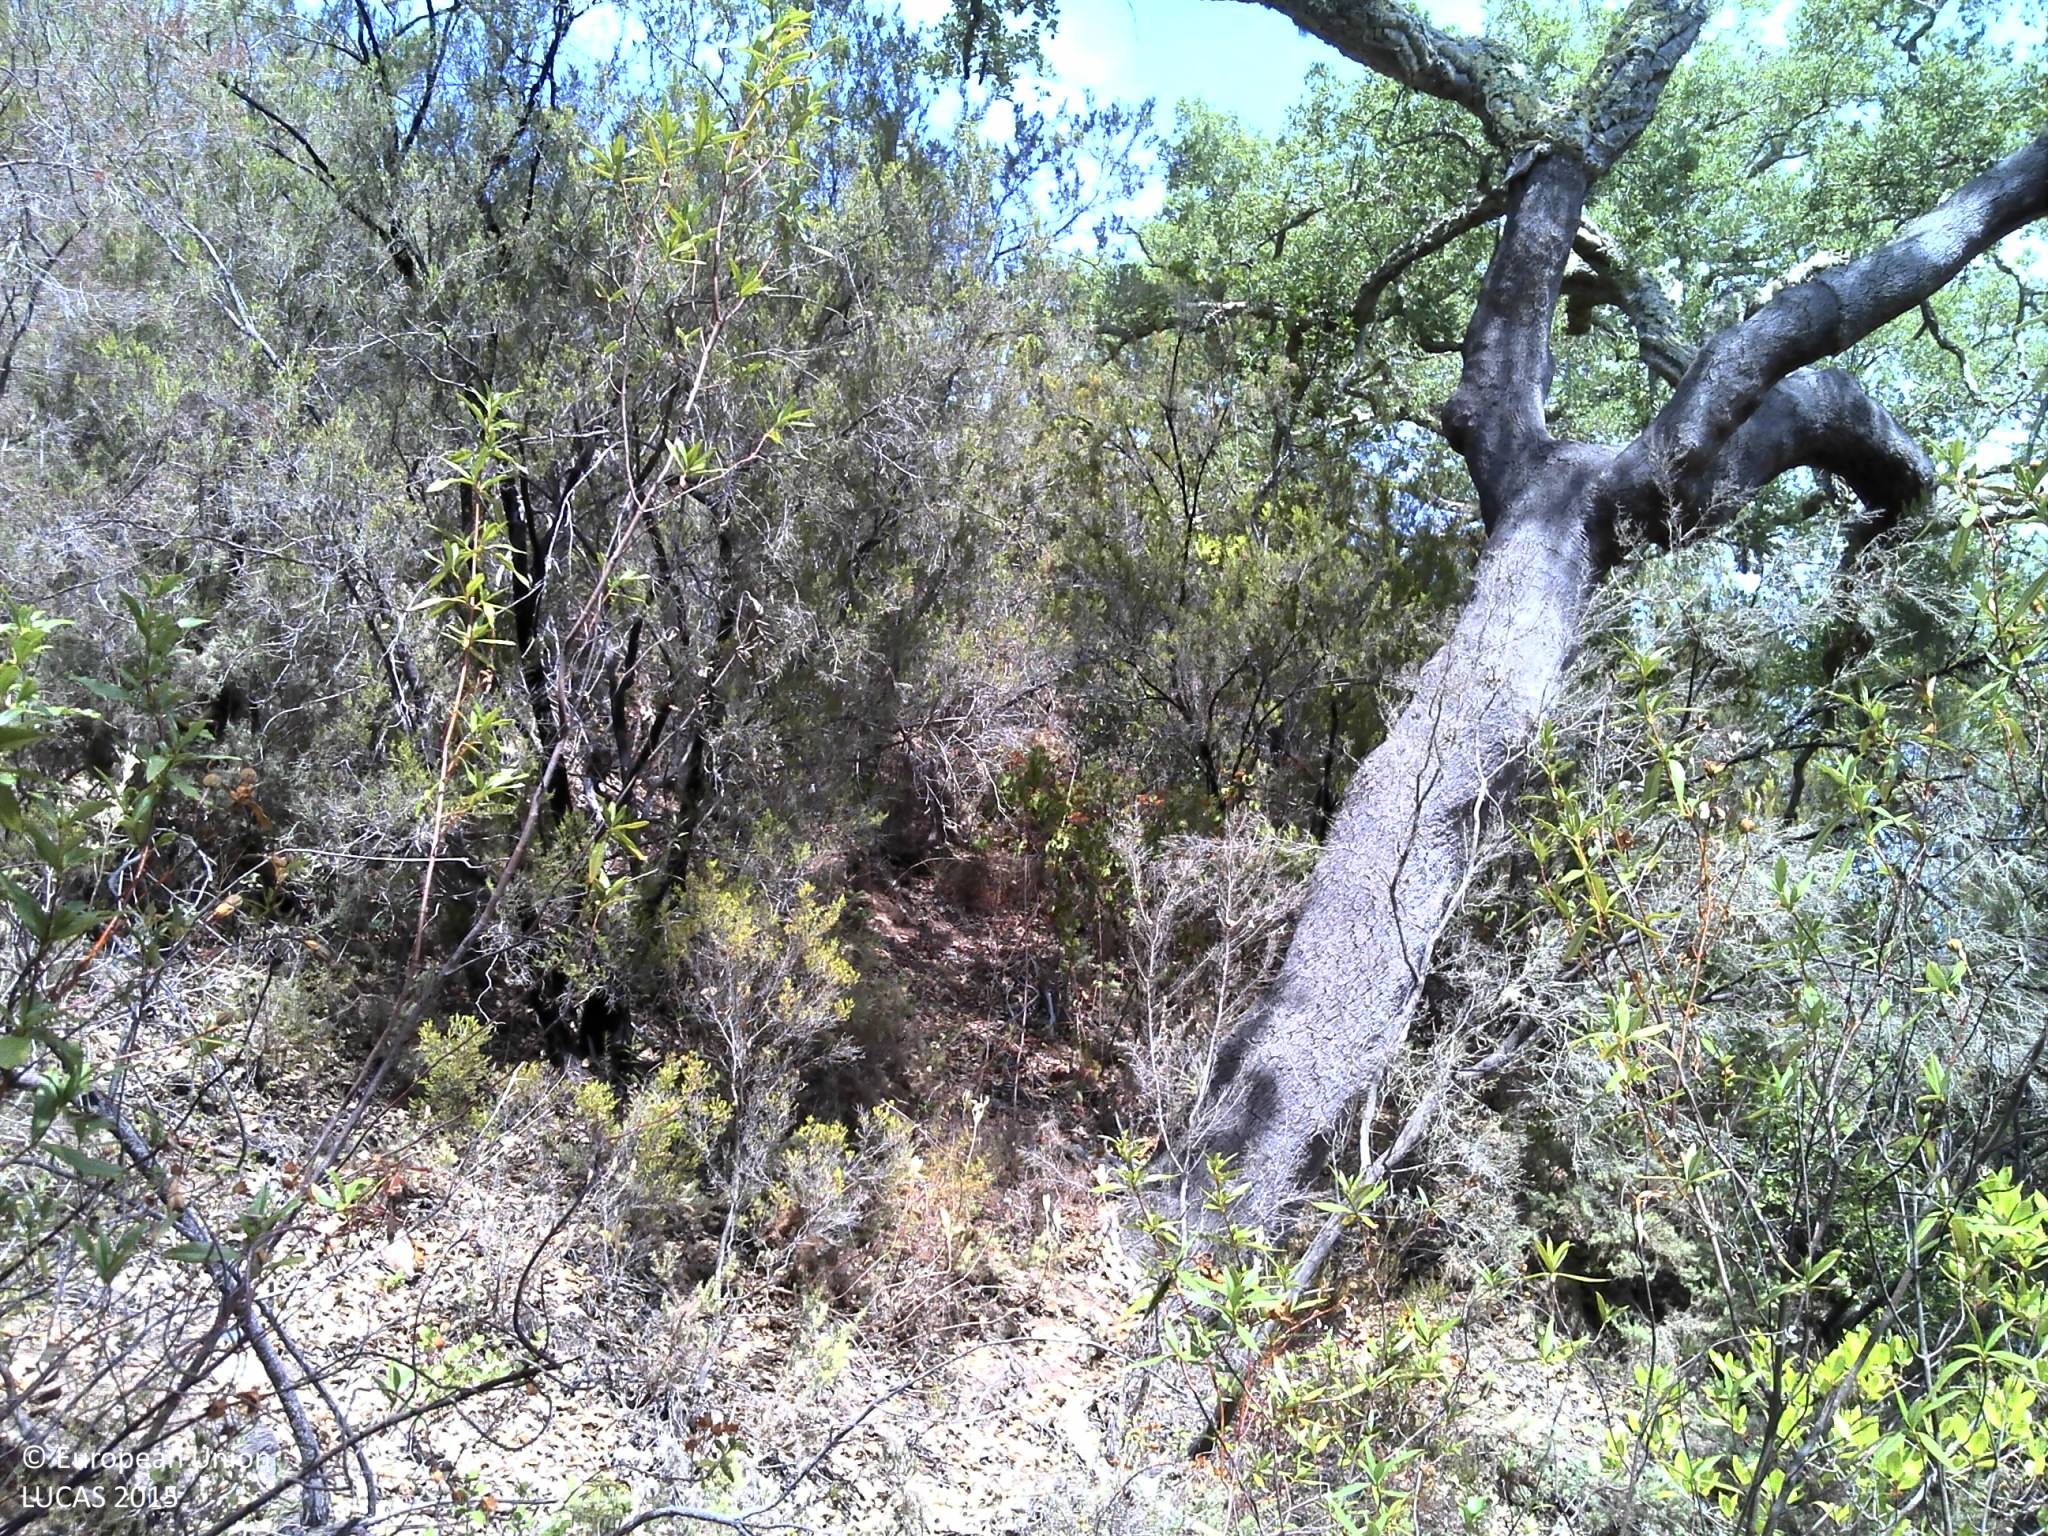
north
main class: Woodland
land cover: Broadleaved woodland
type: broadleaved evergreen forest
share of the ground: 25 - 50 %
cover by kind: shrubs 50 %, broadleaved forest trees 30 %, unconsolidated bare surface 20 %
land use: Forestry
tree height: > 5 m
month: September
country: PT
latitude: 37.3930
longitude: -8.2434
